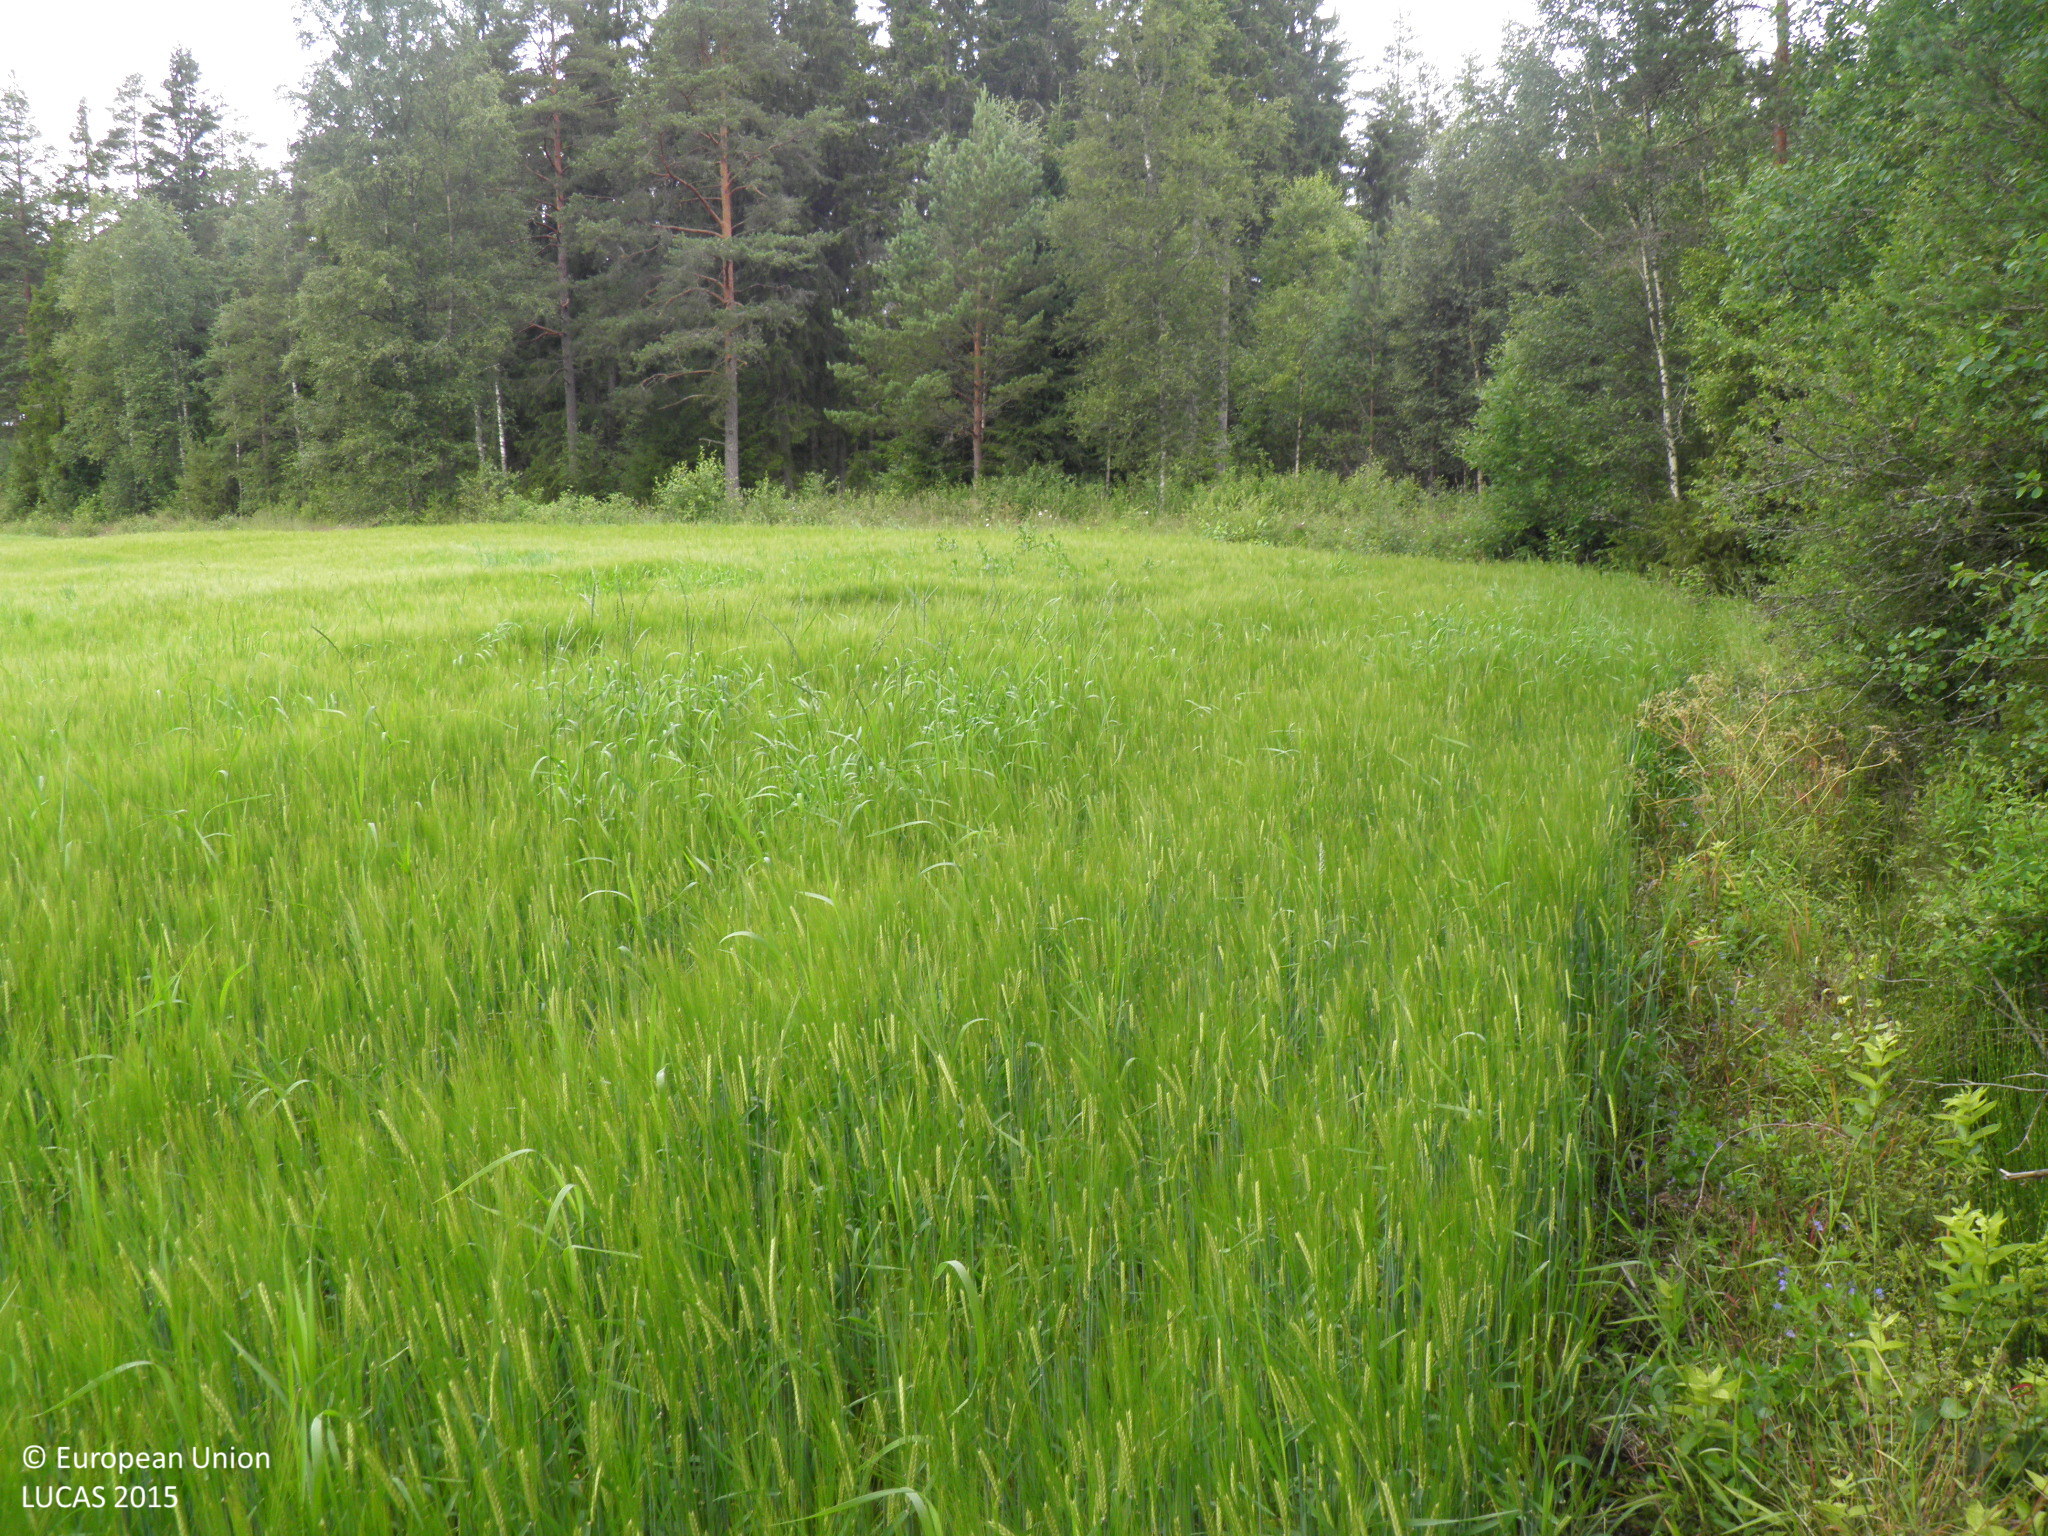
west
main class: Cropland
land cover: Barley
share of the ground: > 75 %
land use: Agriculture (excluding fallow land and kitchen gardens)
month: July
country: FI
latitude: 60.7044
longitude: 21.5803
